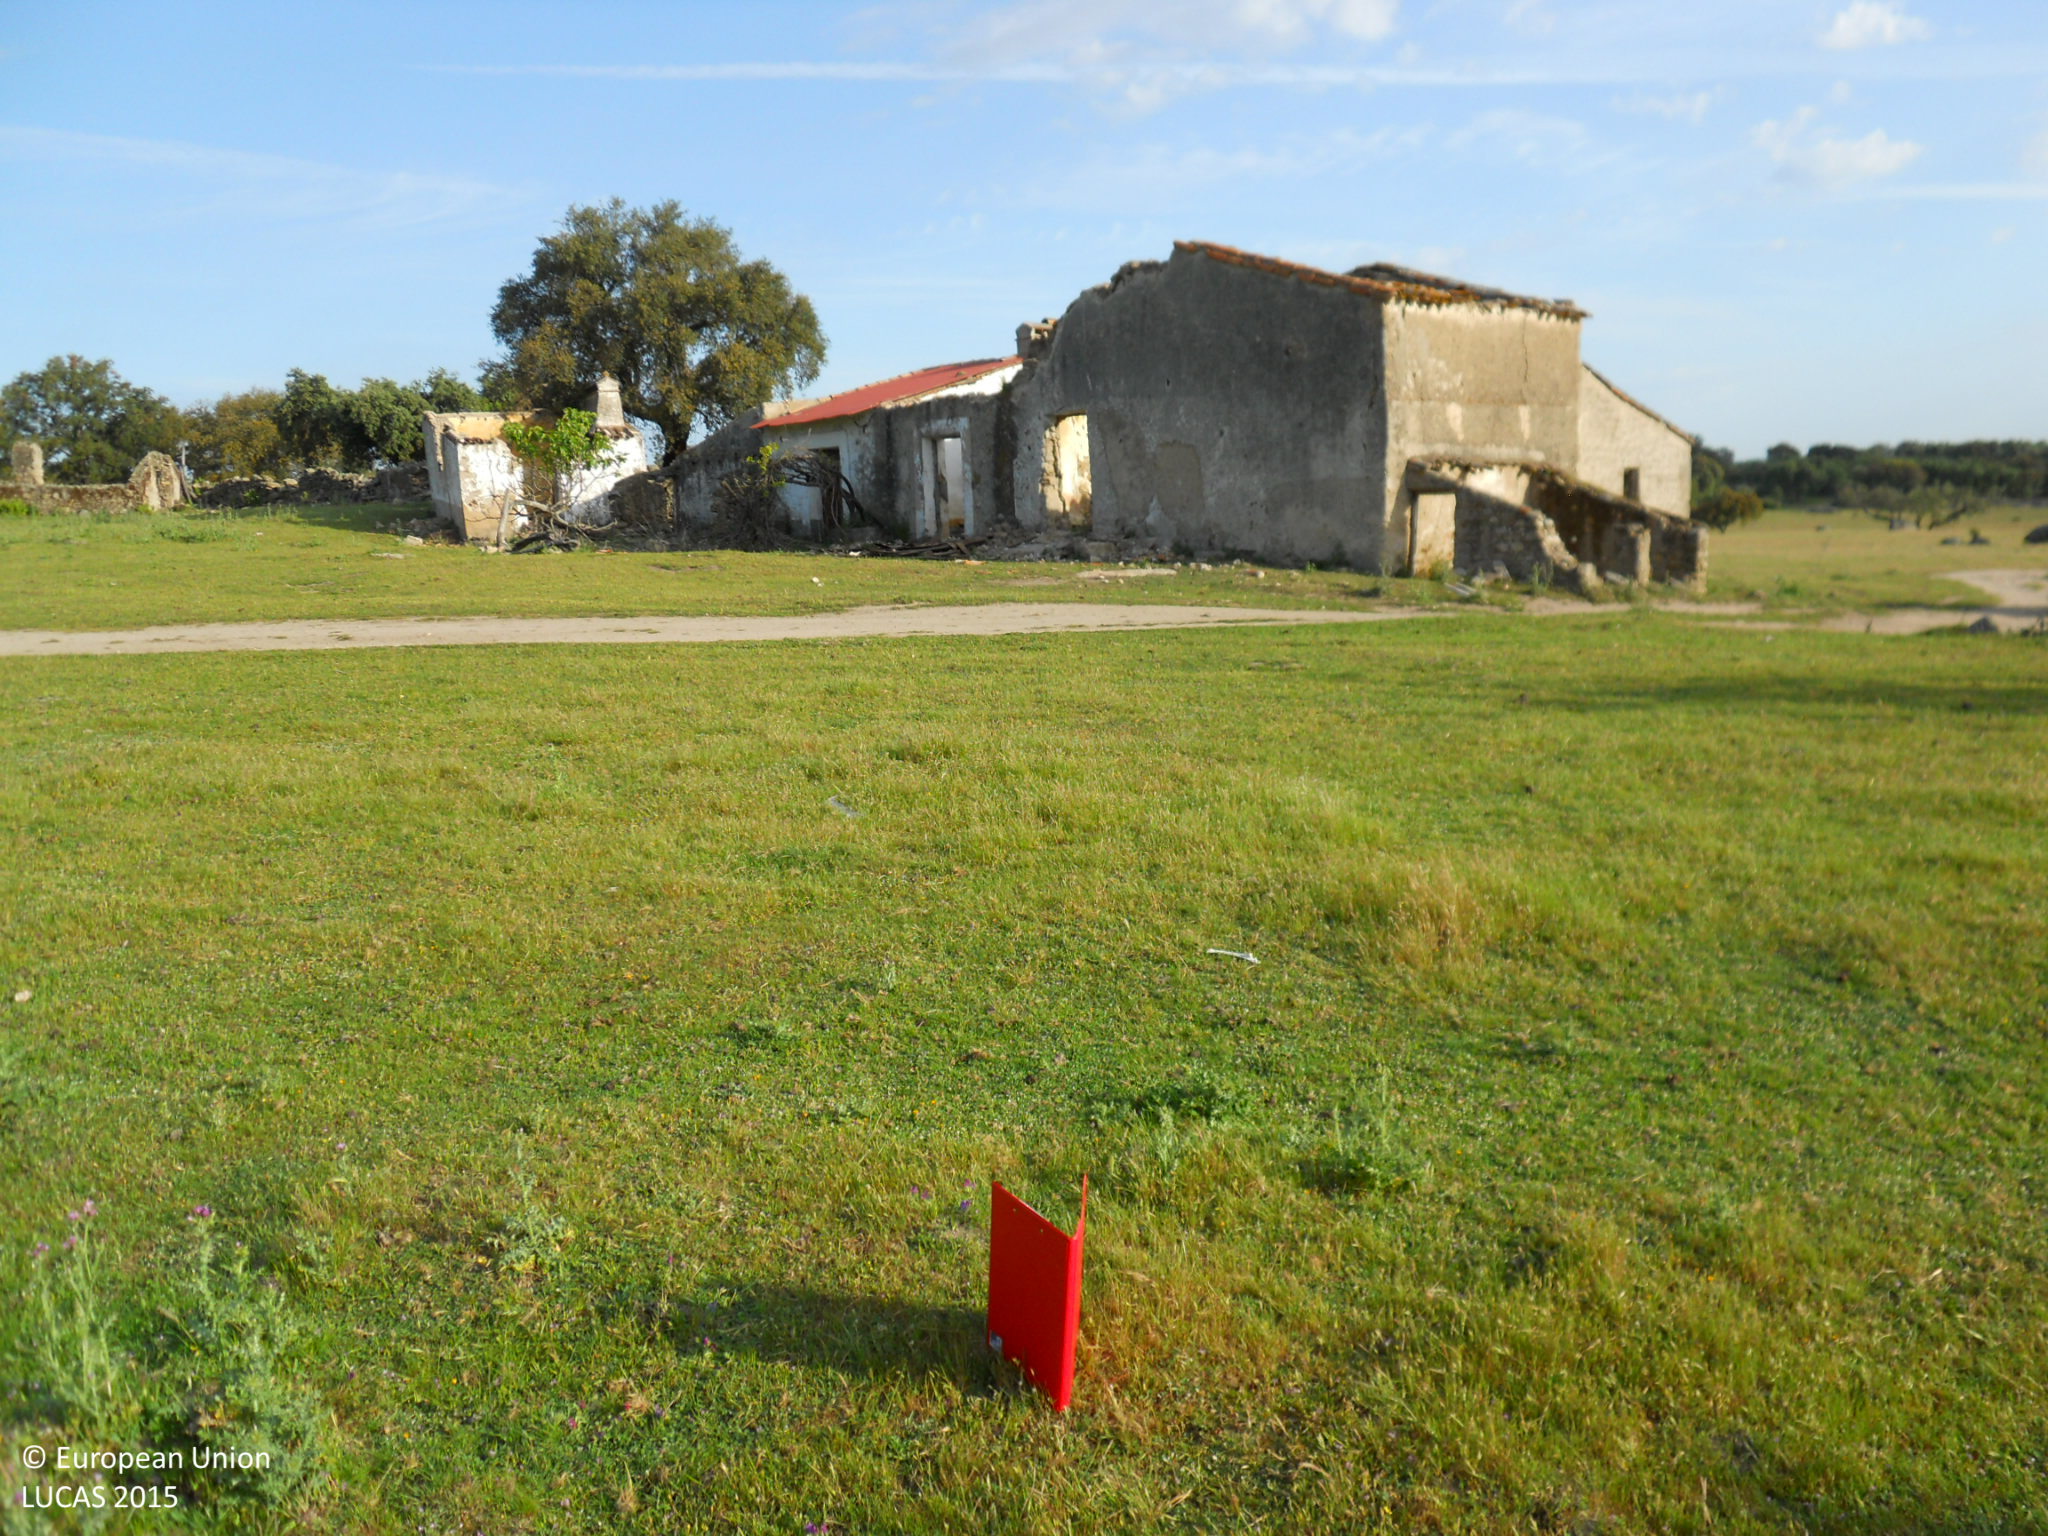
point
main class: Cropland
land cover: Other fruit trees and berries
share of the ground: < 10 %
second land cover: Spontaneously vegetated surfaces
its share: > 75 %
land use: Agriculture (excluding fallow land and kitchen gardens)
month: April
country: ES
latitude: 39.2185
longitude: -6.9748
